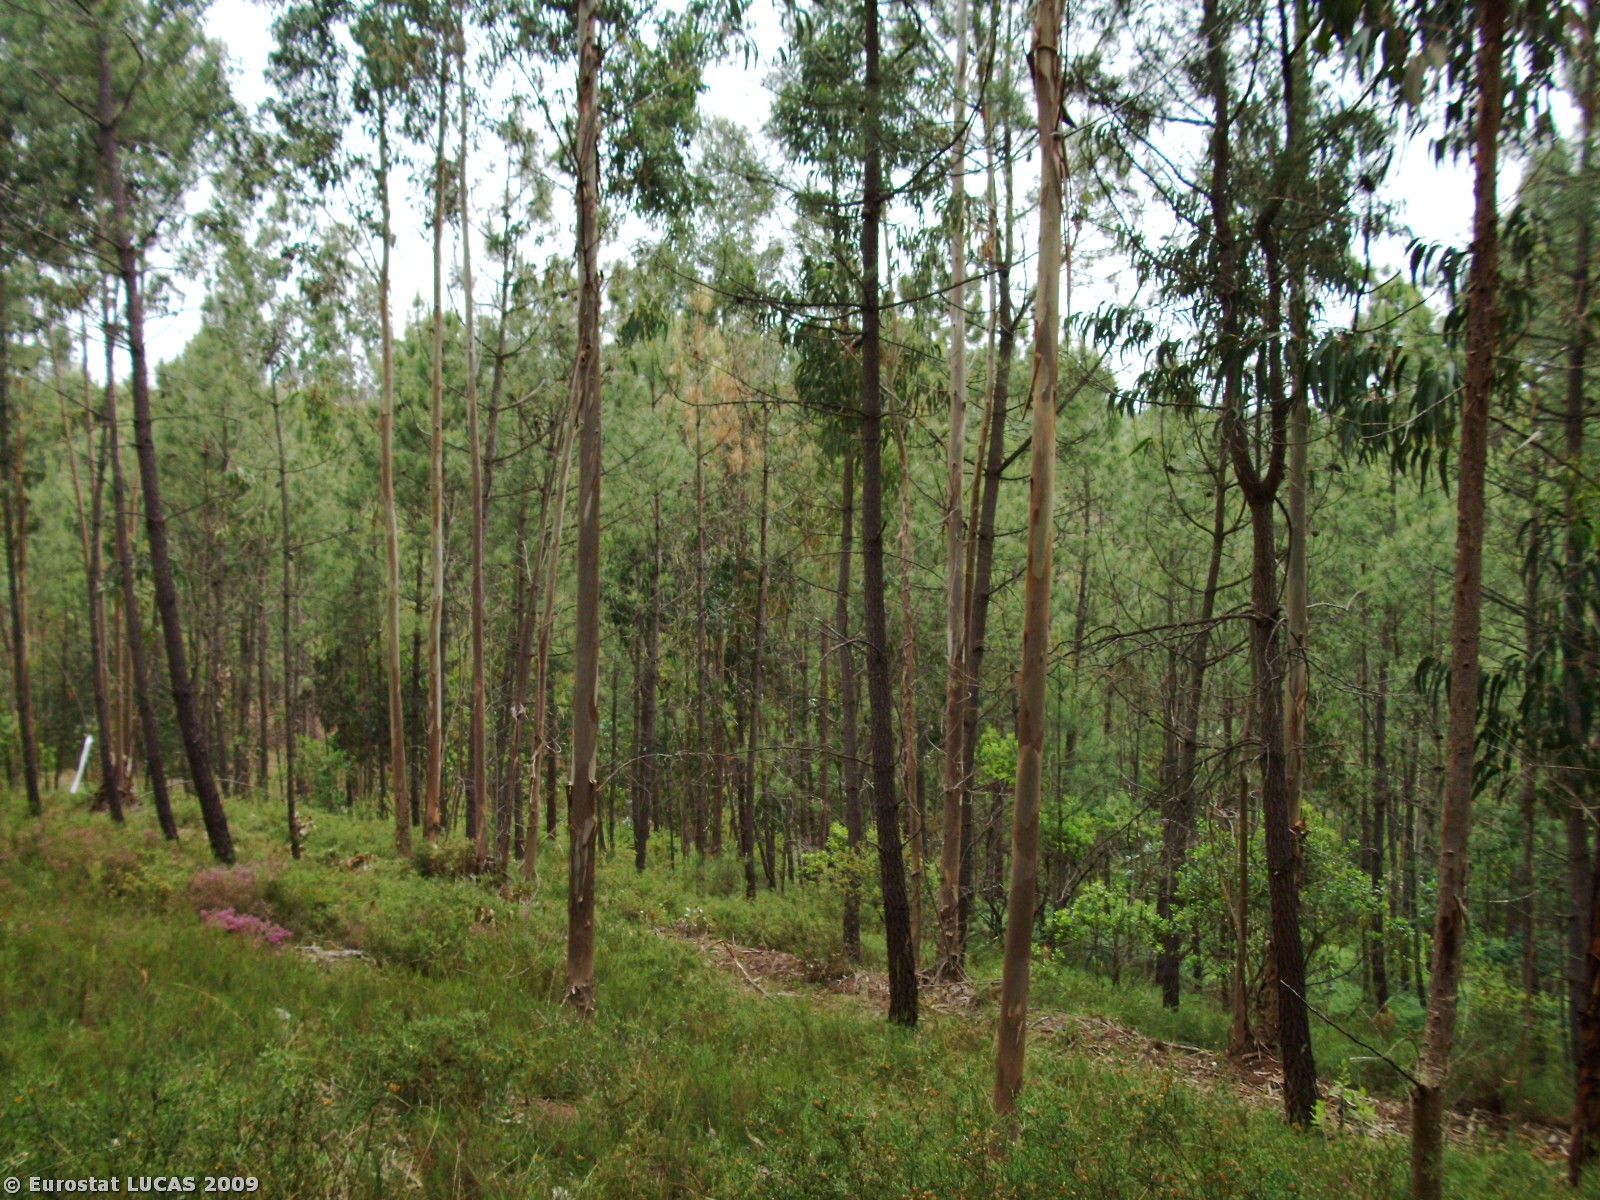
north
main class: Woodland
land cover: Mixed woodland
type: coniferous forest of the mediterranean region
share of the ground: > 75 %
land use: Forestry
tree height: > 5 m
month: May
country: PT
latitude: 40.4171
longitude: -8.3886
